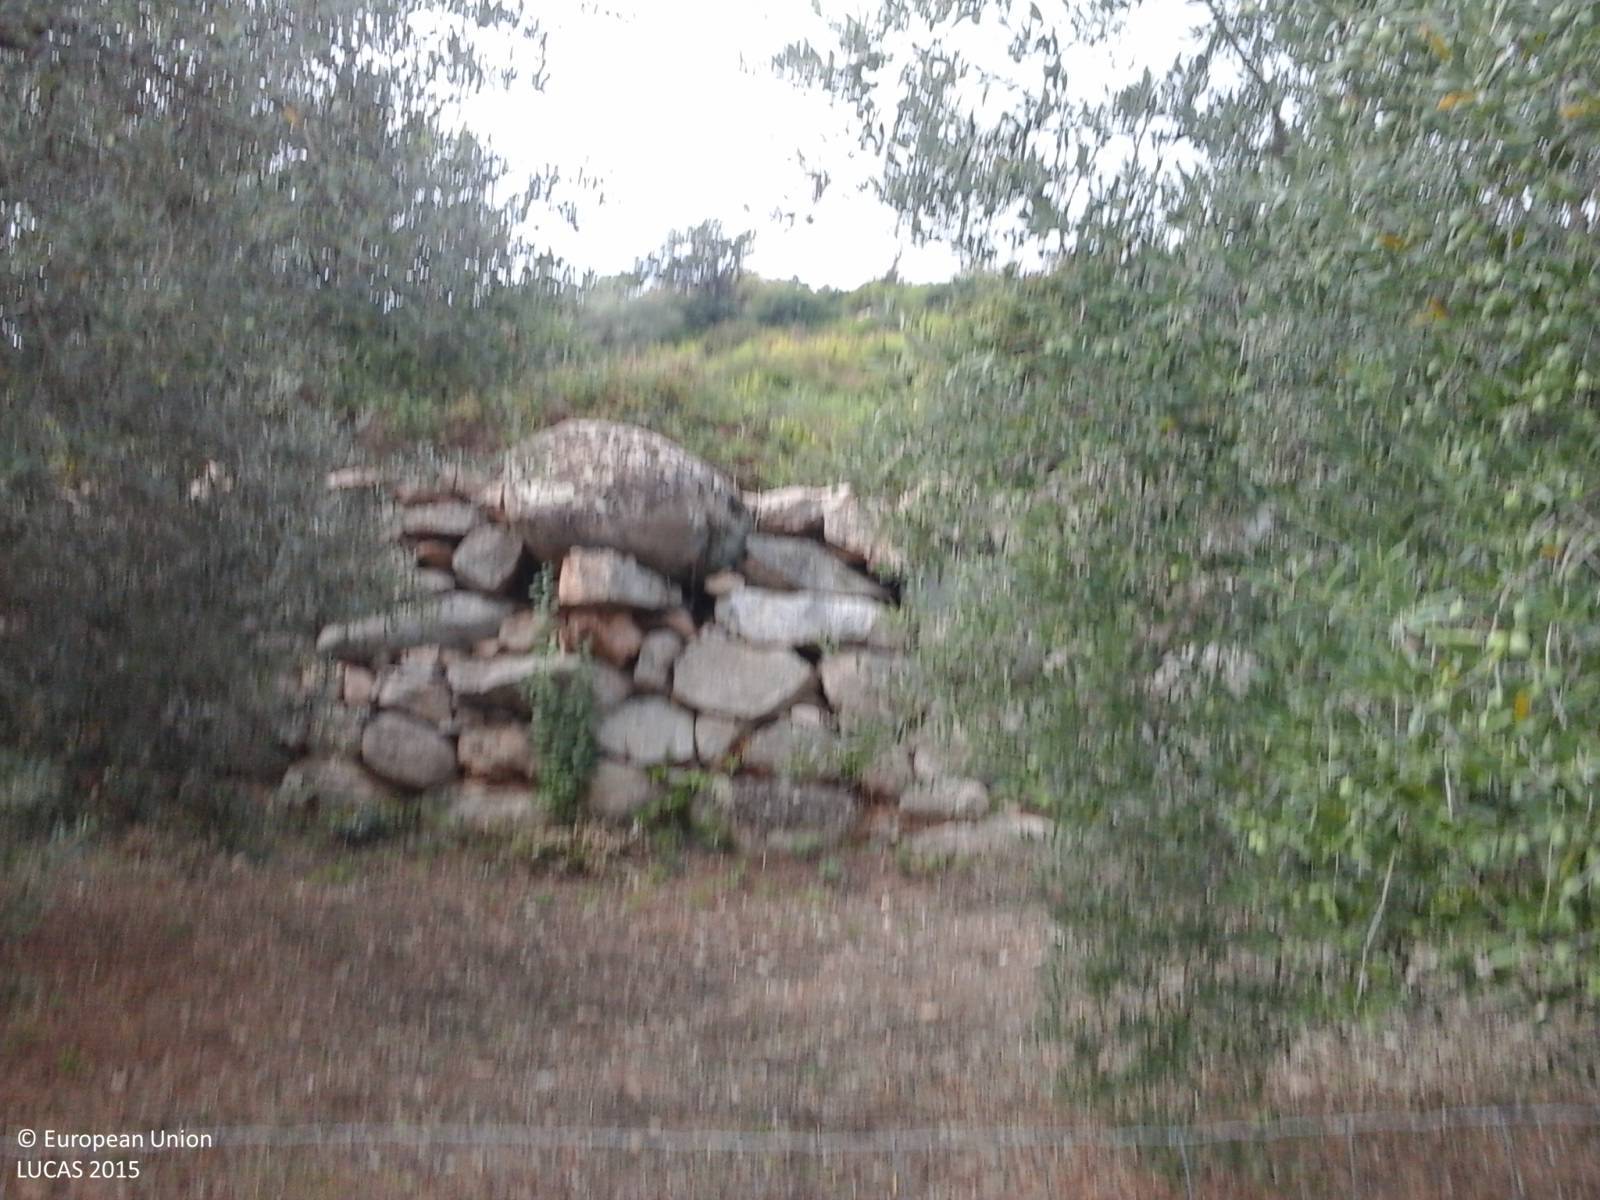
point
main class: Shrubland
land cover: Shrubland without tree cover
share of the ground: > 75 %
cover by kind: shrubs 65 %, unconsolidated bare surface 30 %, herbaceous plants 5 %
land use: Semi-natural and natural areas not in use
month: September
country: IT
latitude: 39.8680
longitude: 9.5699
